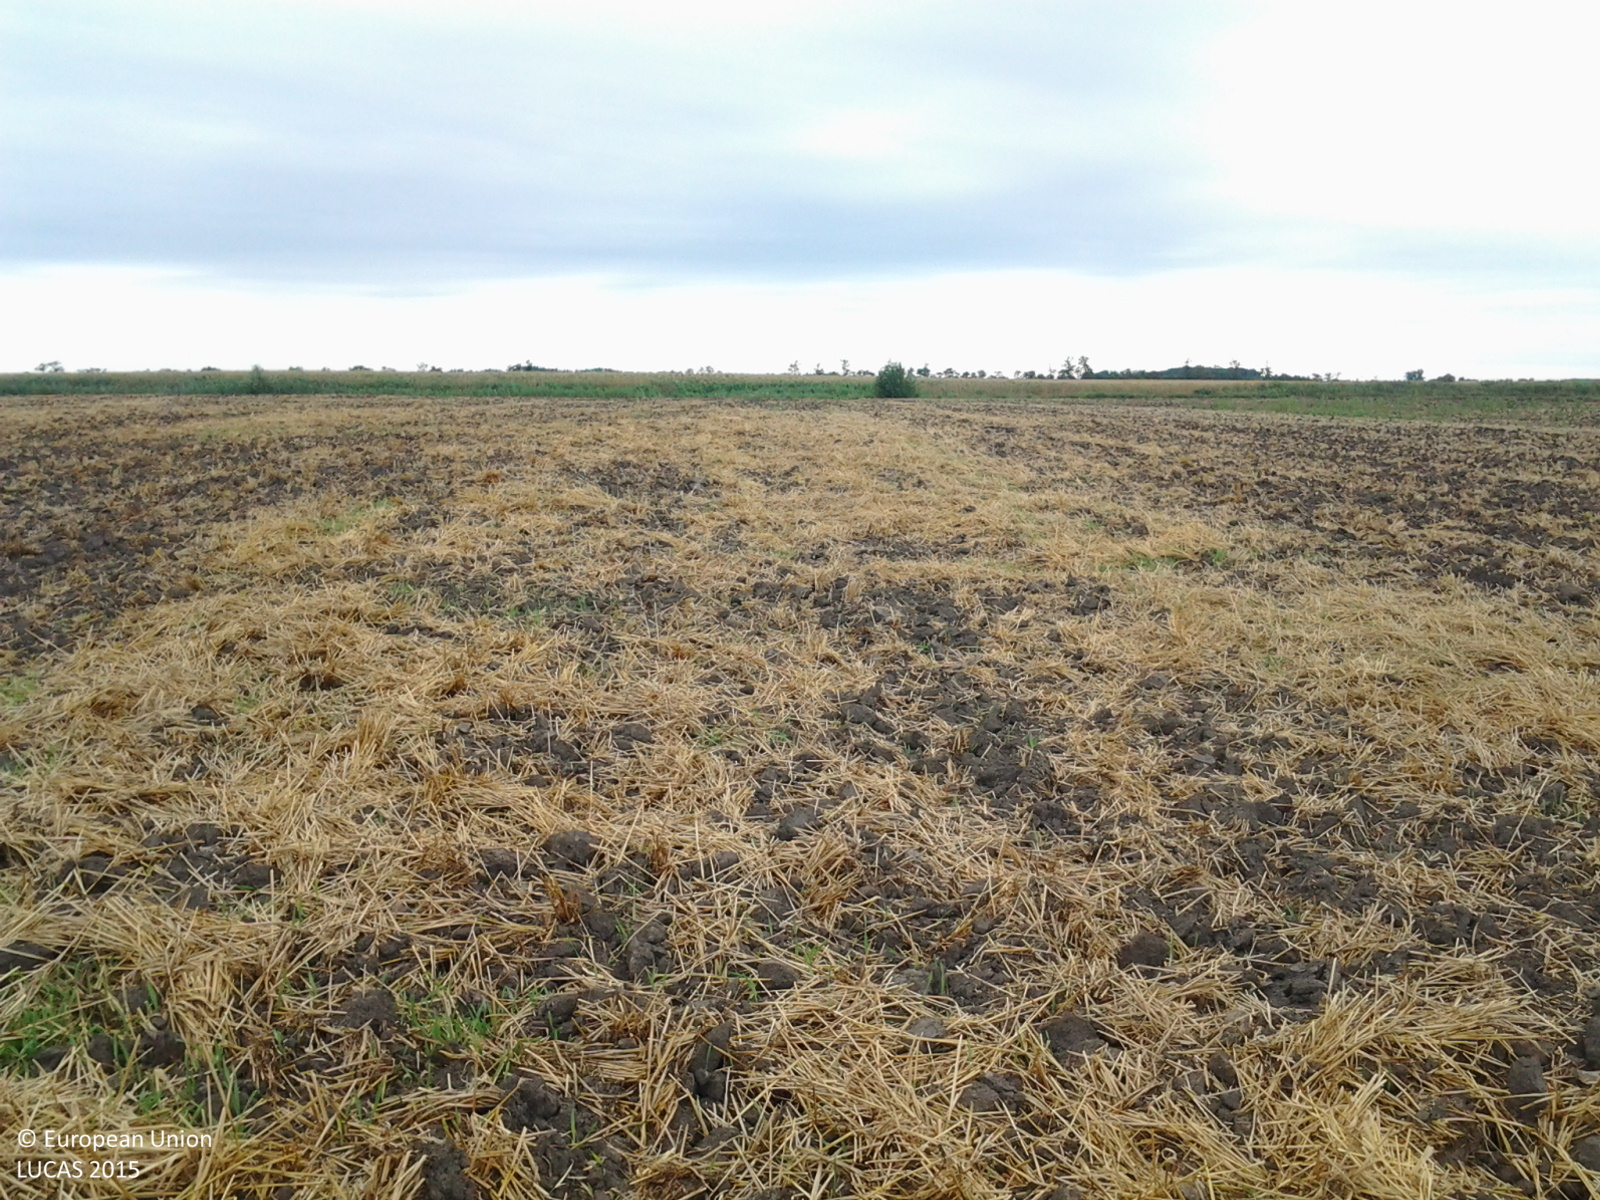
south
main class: Cropland
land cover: Barley
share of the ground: < 10 %
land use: Agriculture (excluding fallow land and kitchen gardens)
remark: Harvested field
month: July
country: HU
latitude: 47.1719
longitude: 20.5452
